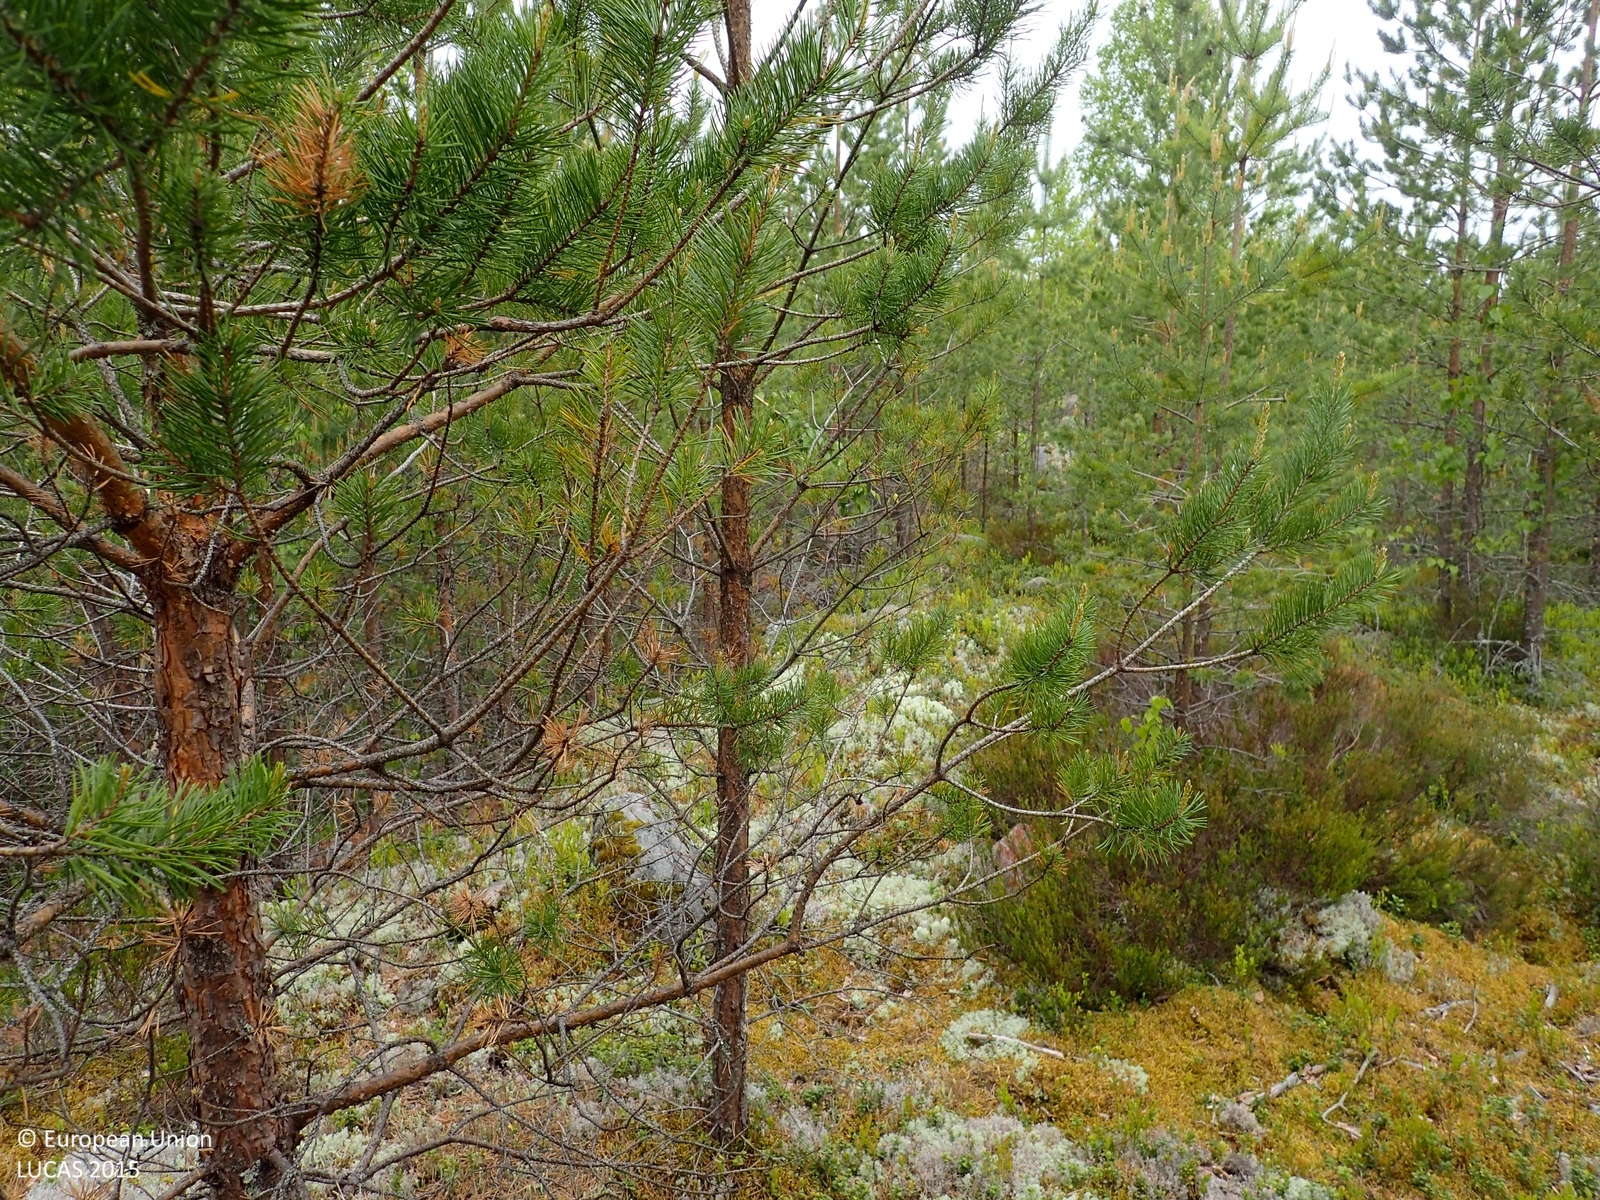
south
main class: Woodland
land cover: Pine dominated coniferous woodland
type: boreal forest
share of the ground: 50 - 75 %
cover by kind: coniferous forest trees 60 %, shrubs 25 %, broadleaved forest trees 5 %, lichens and mosses 5 %, consolidated bare surface 5 %
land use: Forestry
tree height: < 5 m
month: June
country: FI
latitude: 62.4566
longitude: 22.4812
